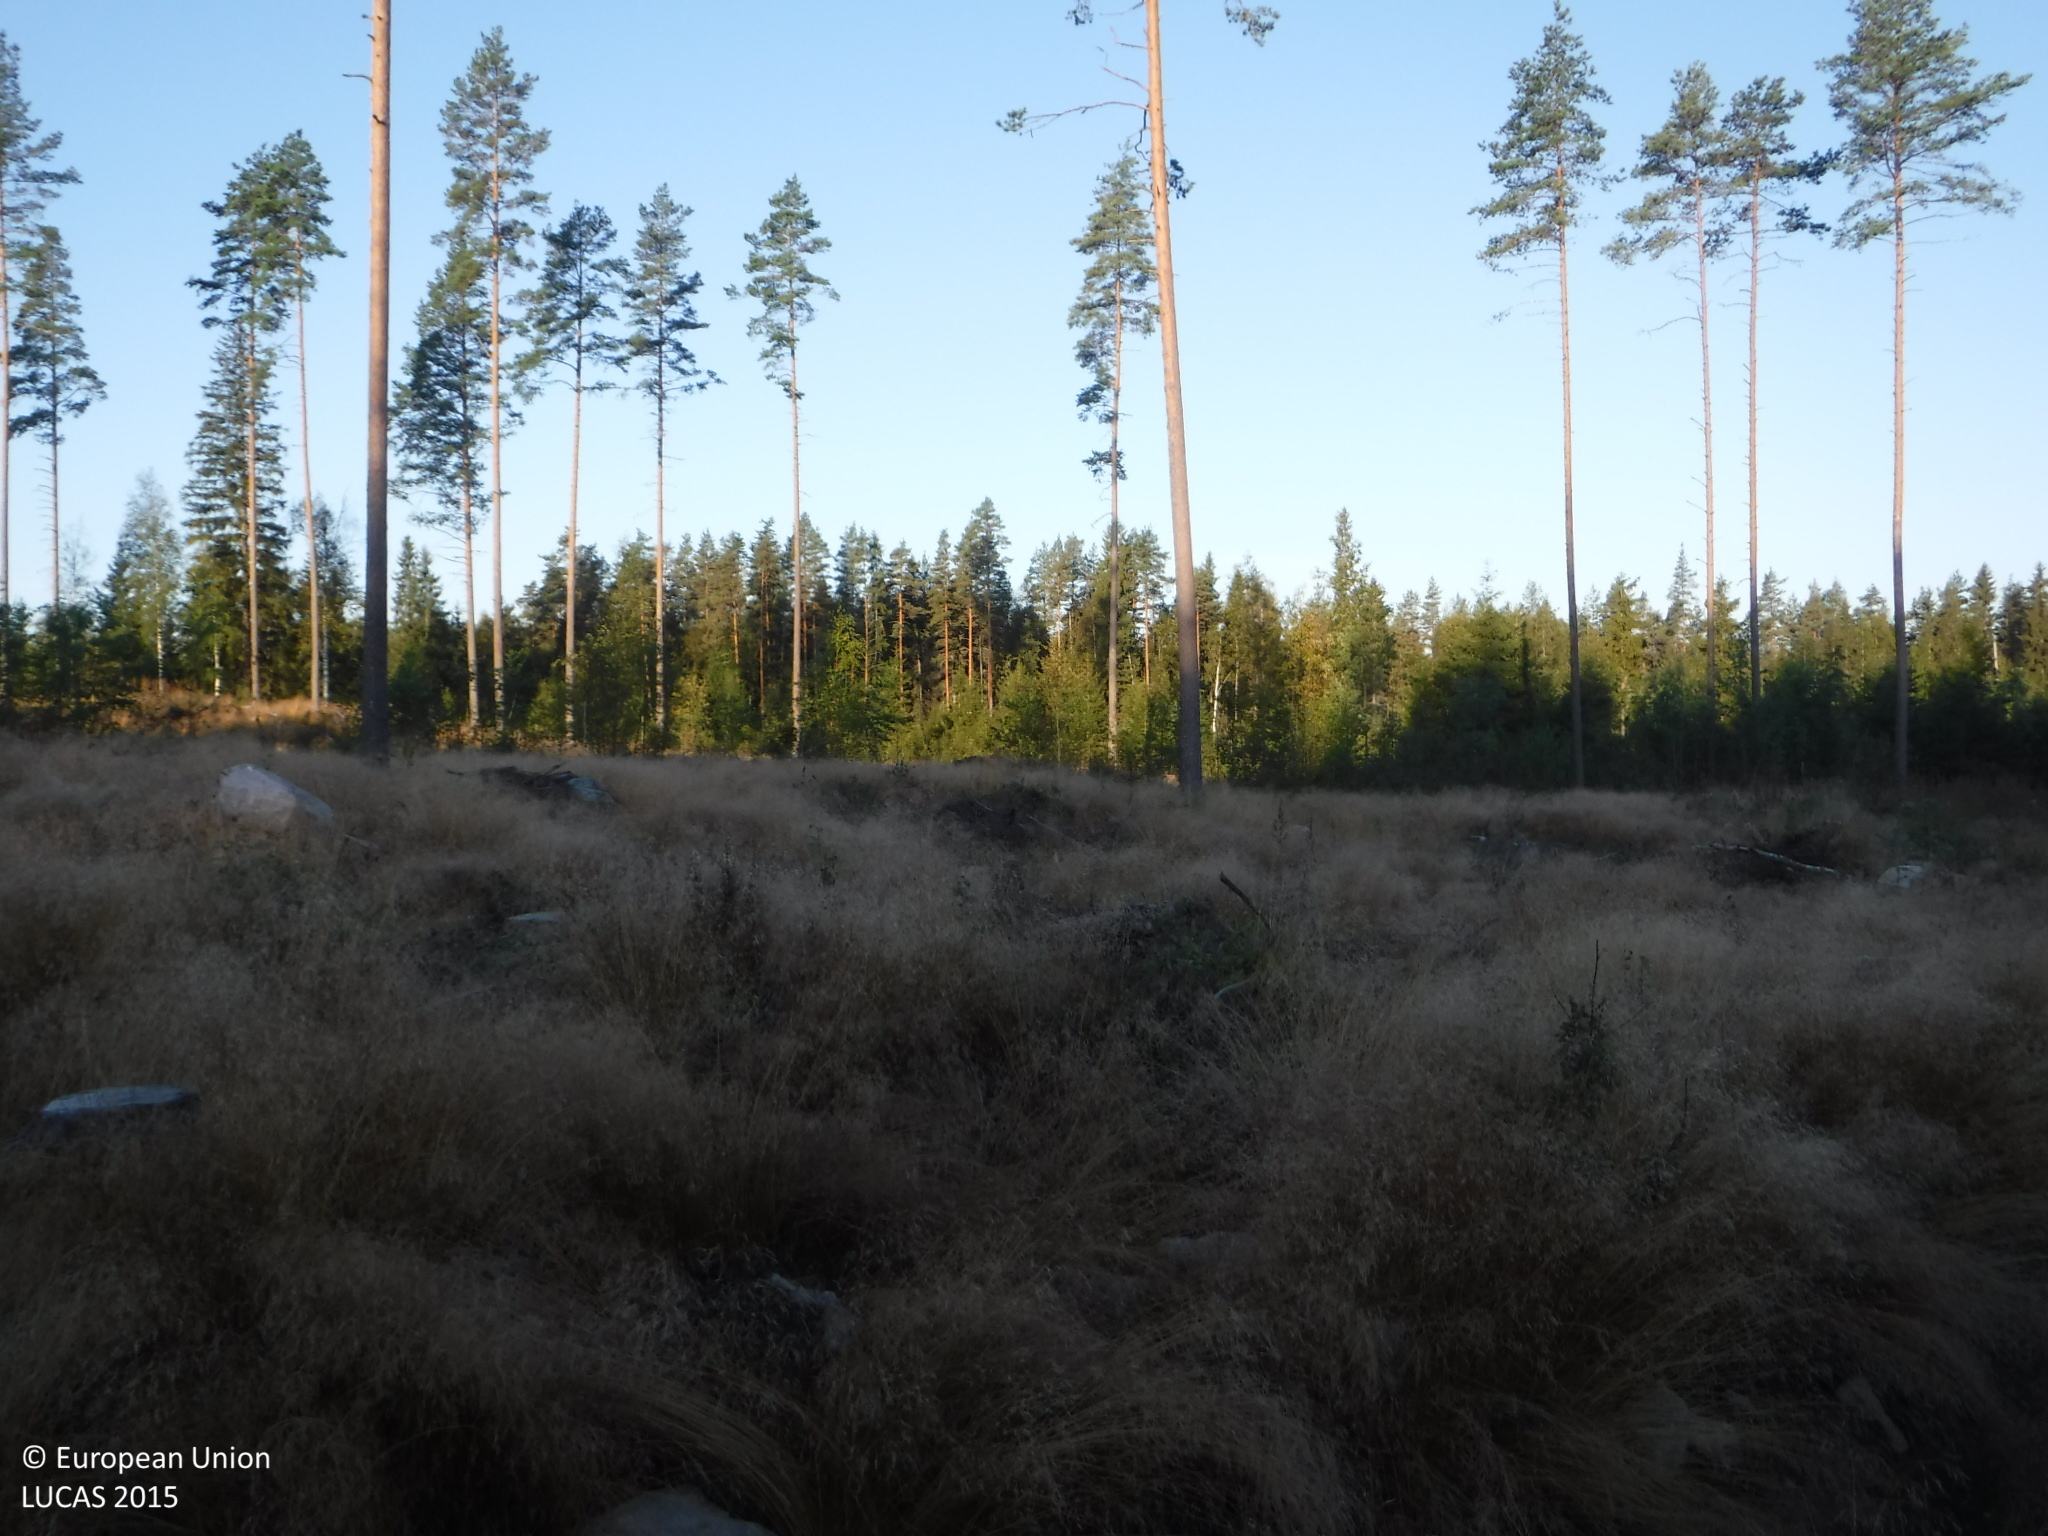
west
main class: Grassland
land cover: Spontaneously vegetated surfaces
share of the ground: 50 - 75 %
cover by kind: herbaceous plants 70 %, unconsolidated bare surface 25 %, consolidated bare surface 5 %
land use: Forestry
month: September
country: FI
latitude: 61.7110
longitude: 22.6424
